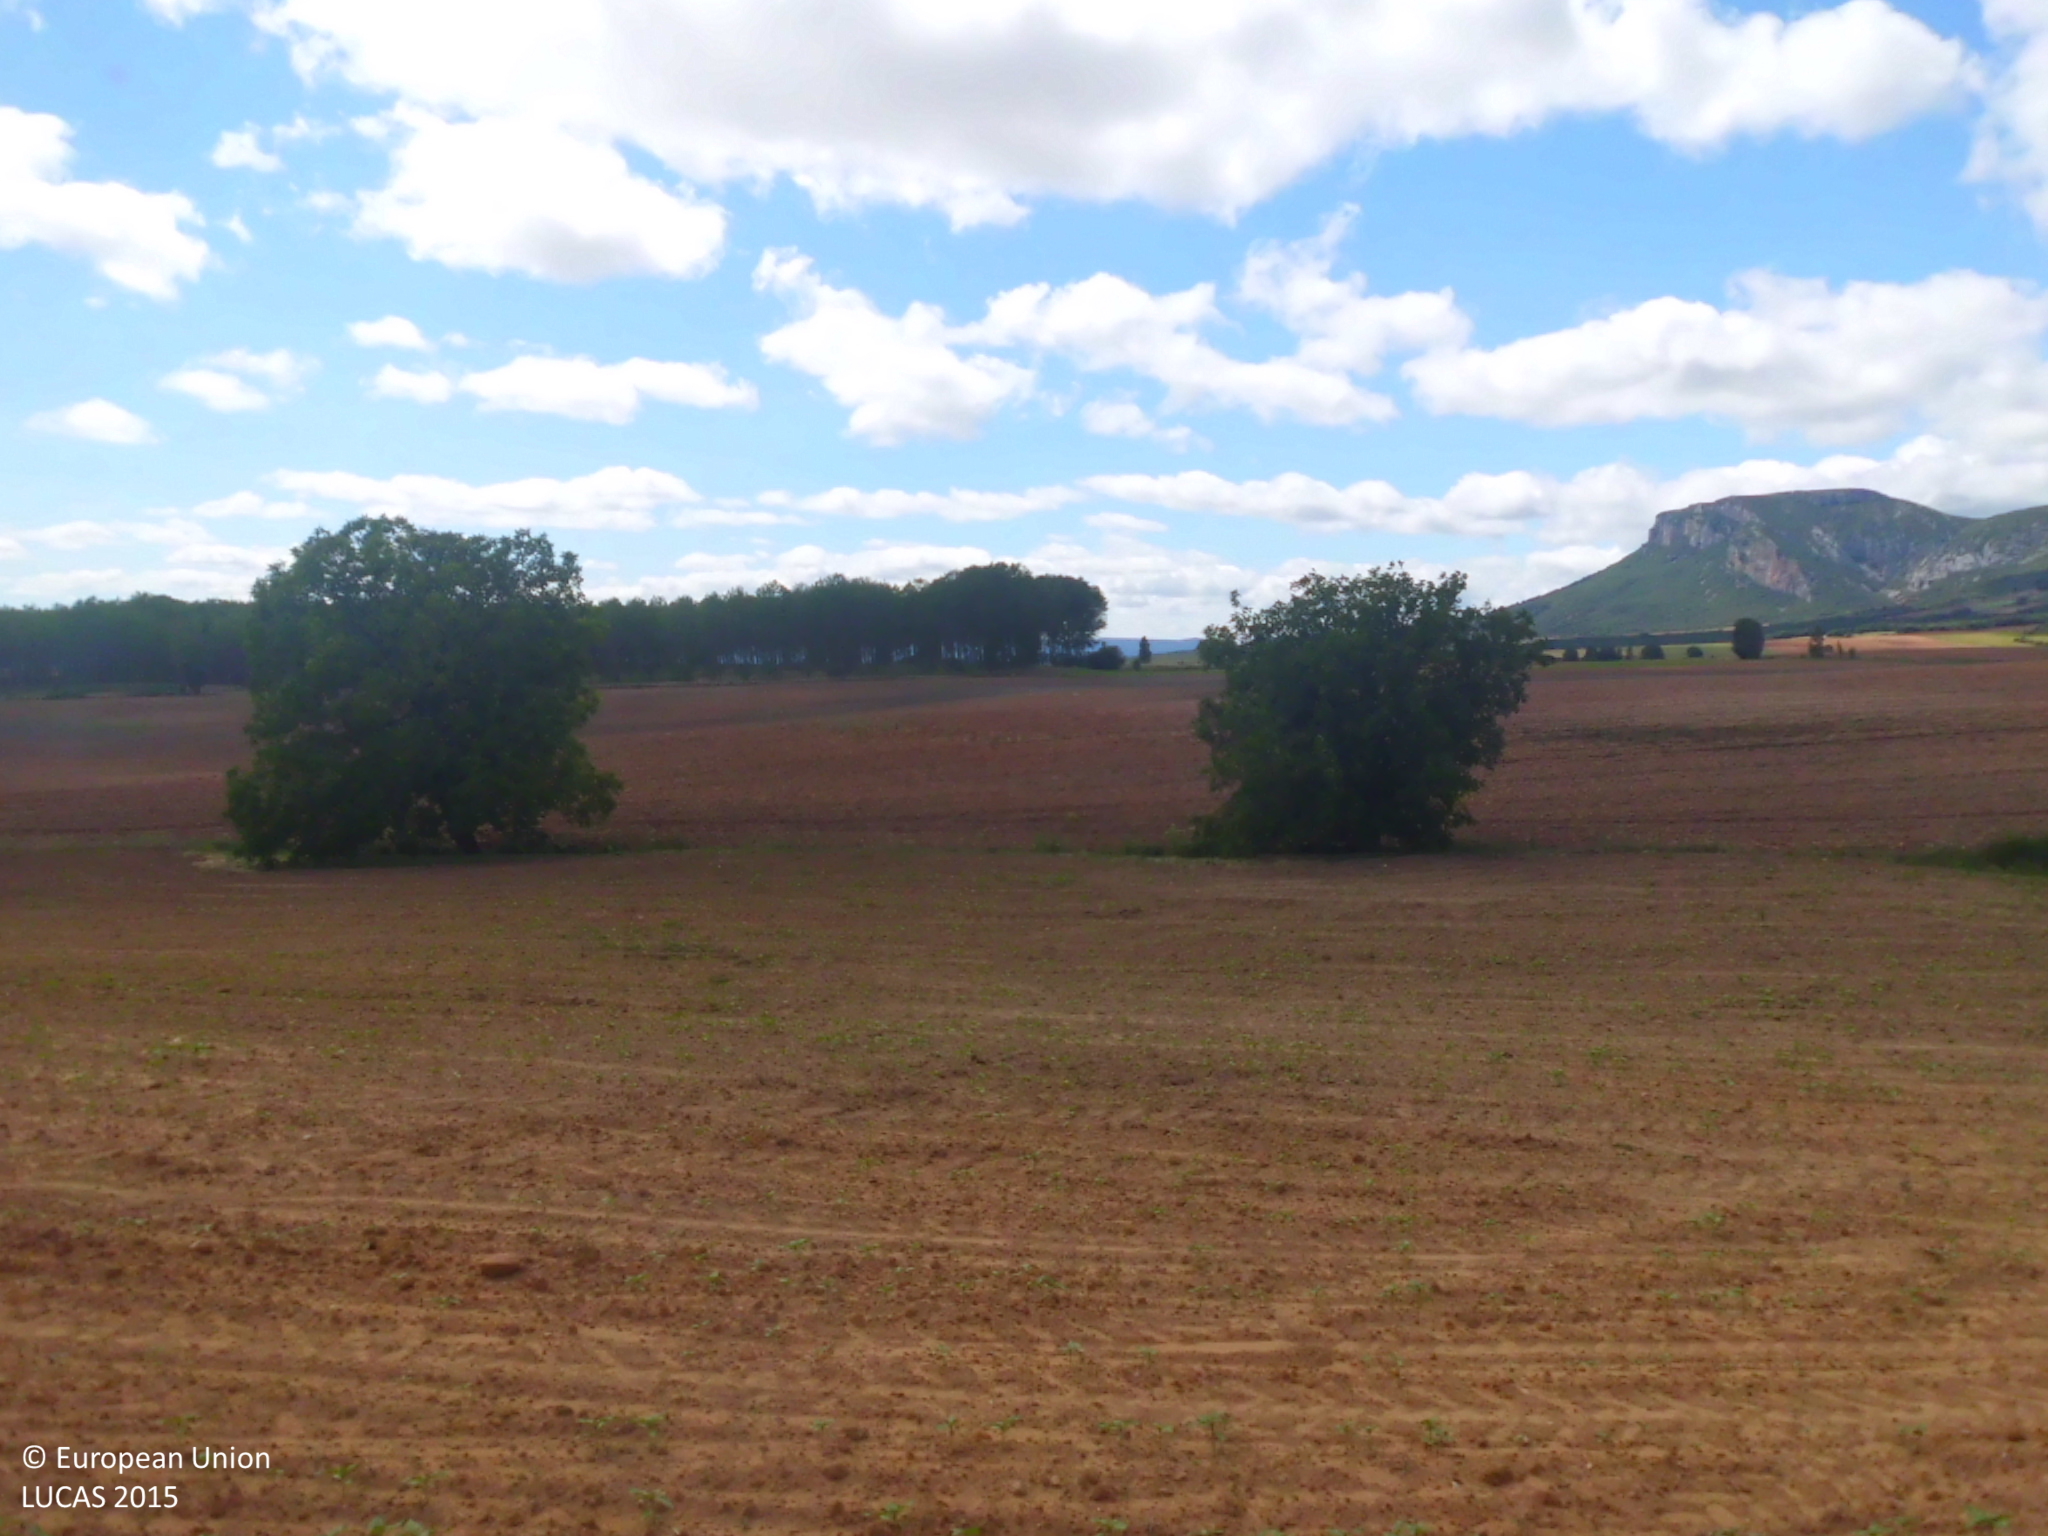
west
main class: Grassland
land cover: Grassland with sparse tree/shrub cover
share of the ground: > 75 %
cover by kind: herbaceous plants 80 %, consolidated bare surface 15 %, broadleaved forest trees 5 %
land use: Agriculture (excluding fallow land and kitchen gardens)
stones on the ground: < 10 %
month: June
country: ES
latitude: 42.6799
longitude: -3.3486
